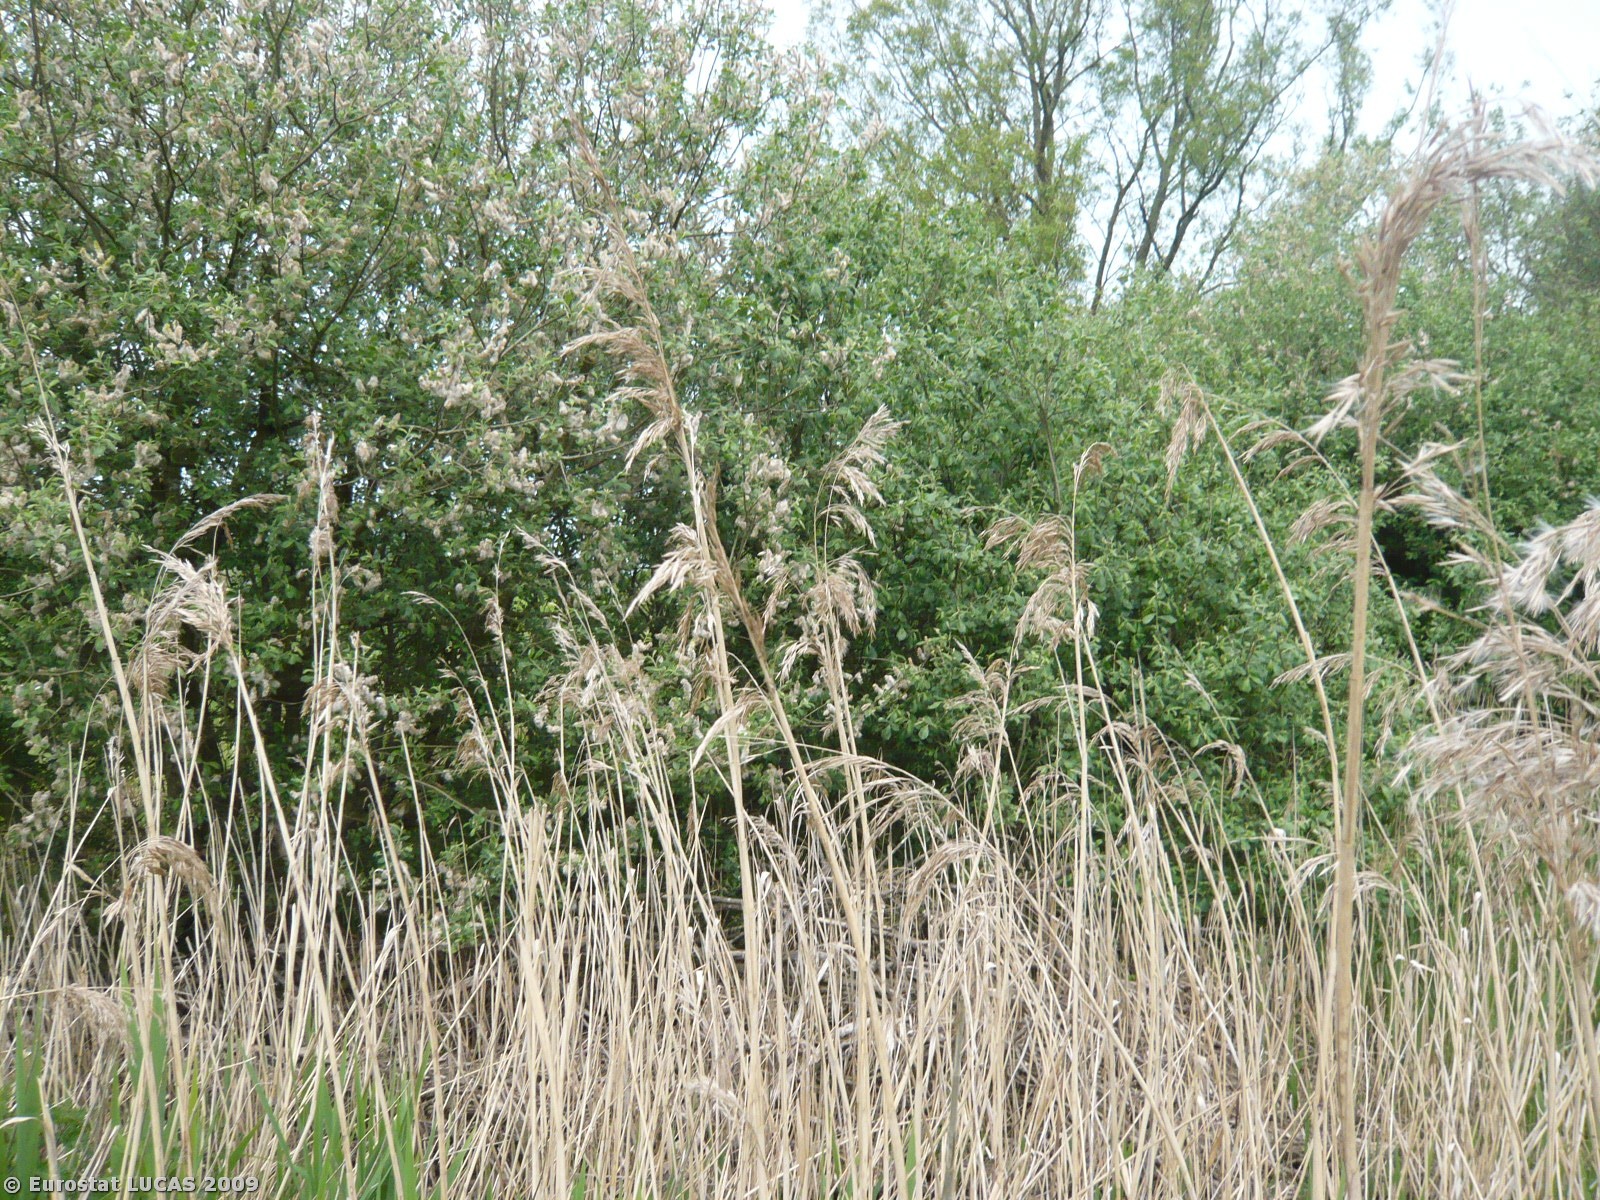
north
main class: Wetlands
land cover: Inland marshes
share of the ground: > 75 %
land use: Unused
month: May
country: DK
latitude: 55.2217
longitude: 11.8378
